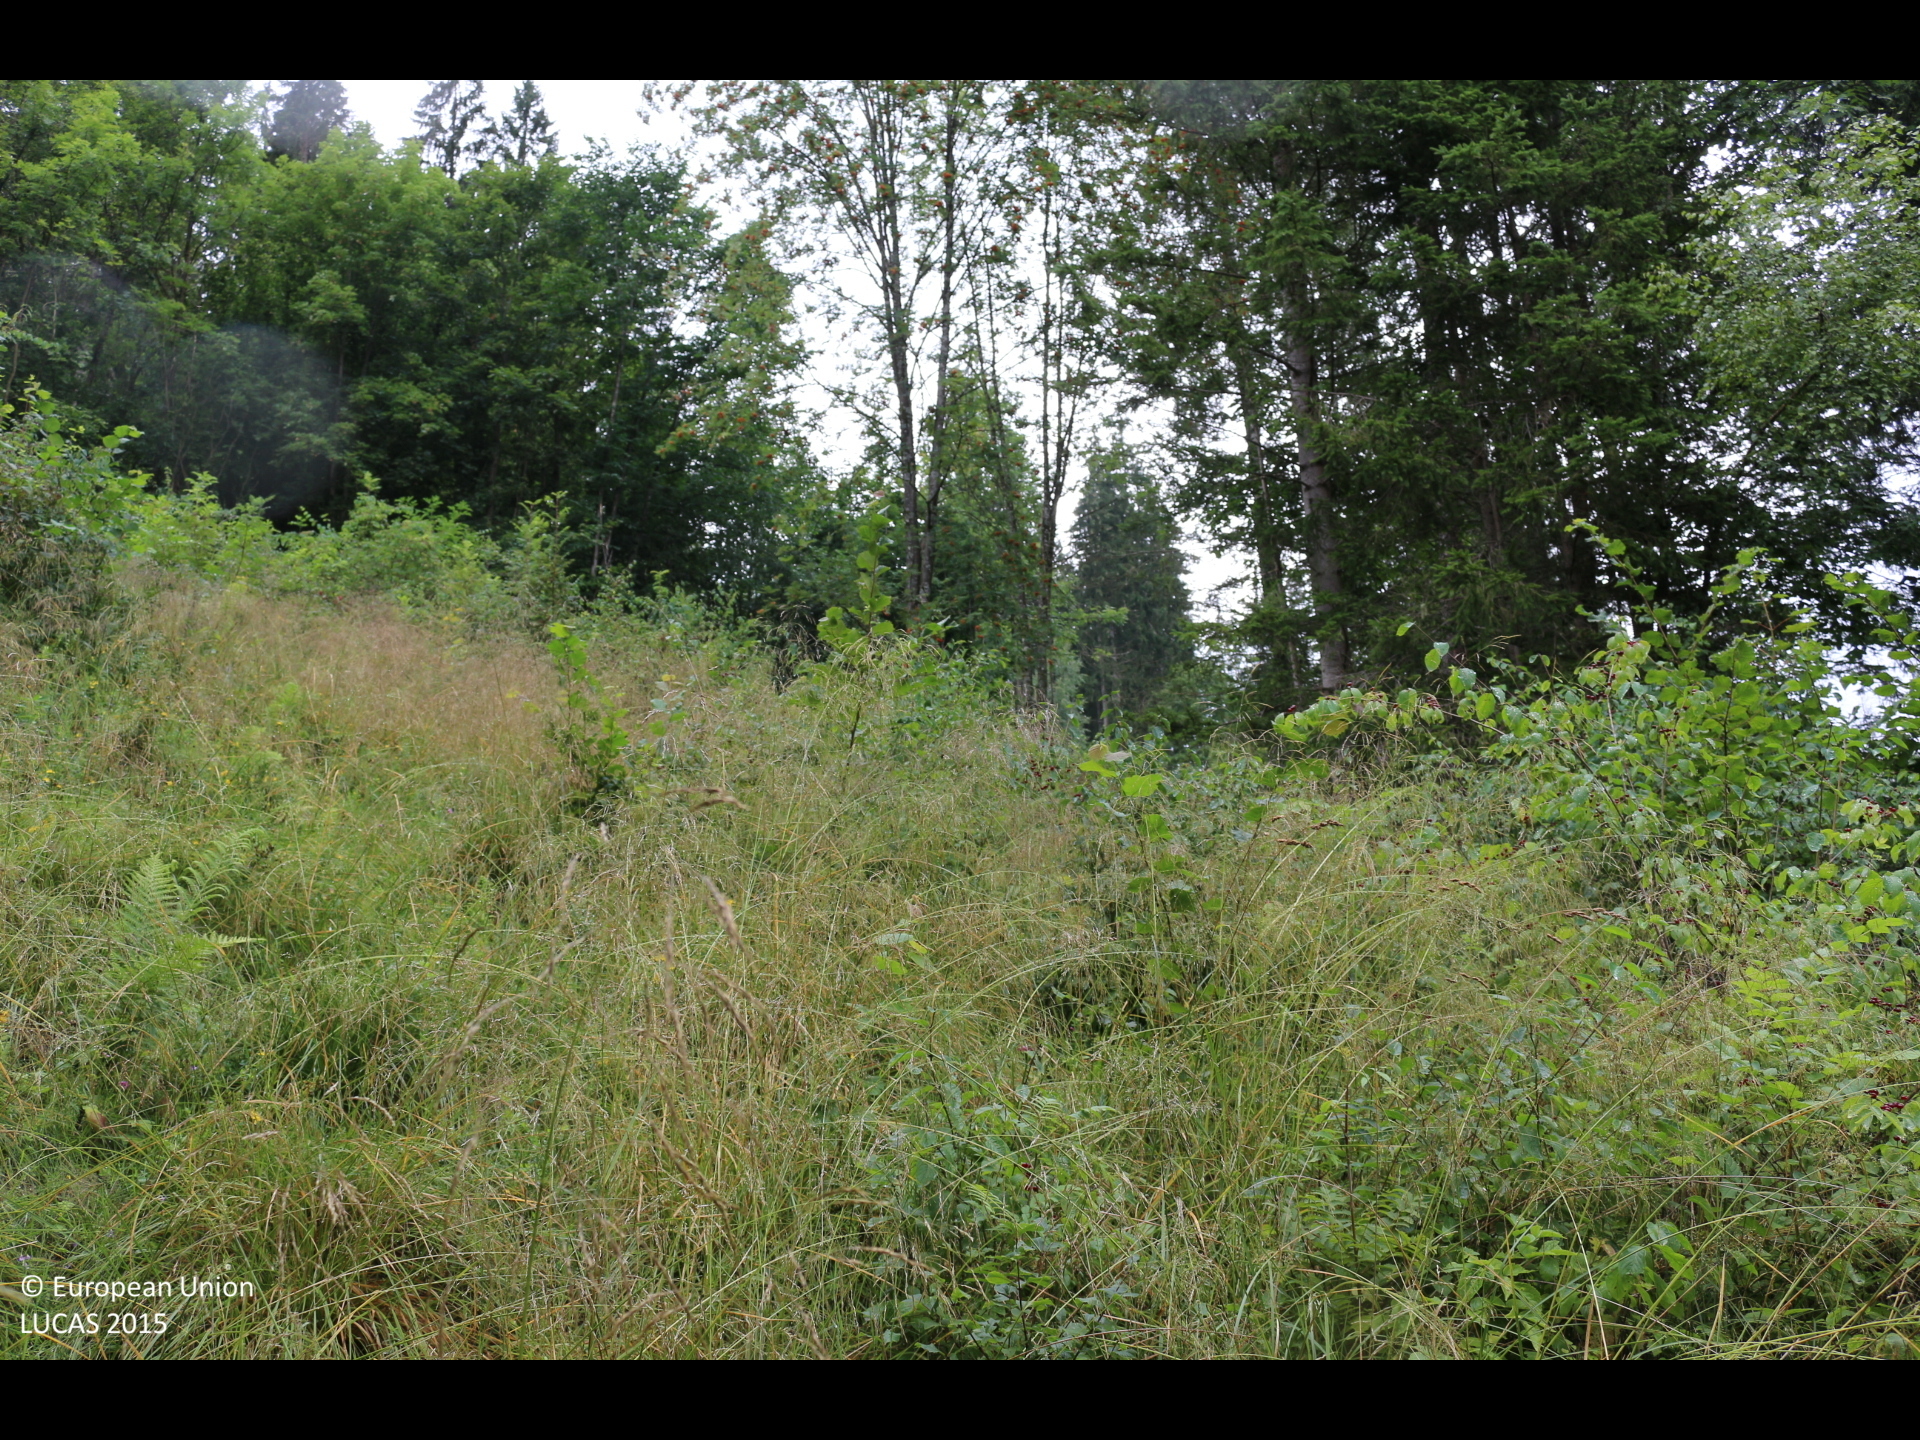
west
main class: Woodland
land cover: Spruce dominated mixed woodland
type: mountainous beech forest
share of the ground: > 75 %
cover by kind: coniferous forest trees 65 %, broadleaved forest trees 25 %, shrubs 5 %, herbaceous plants 5 %
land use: Forestry
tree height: > 5 m
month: July
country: AT
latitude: 46.9682
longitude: 14.2959
